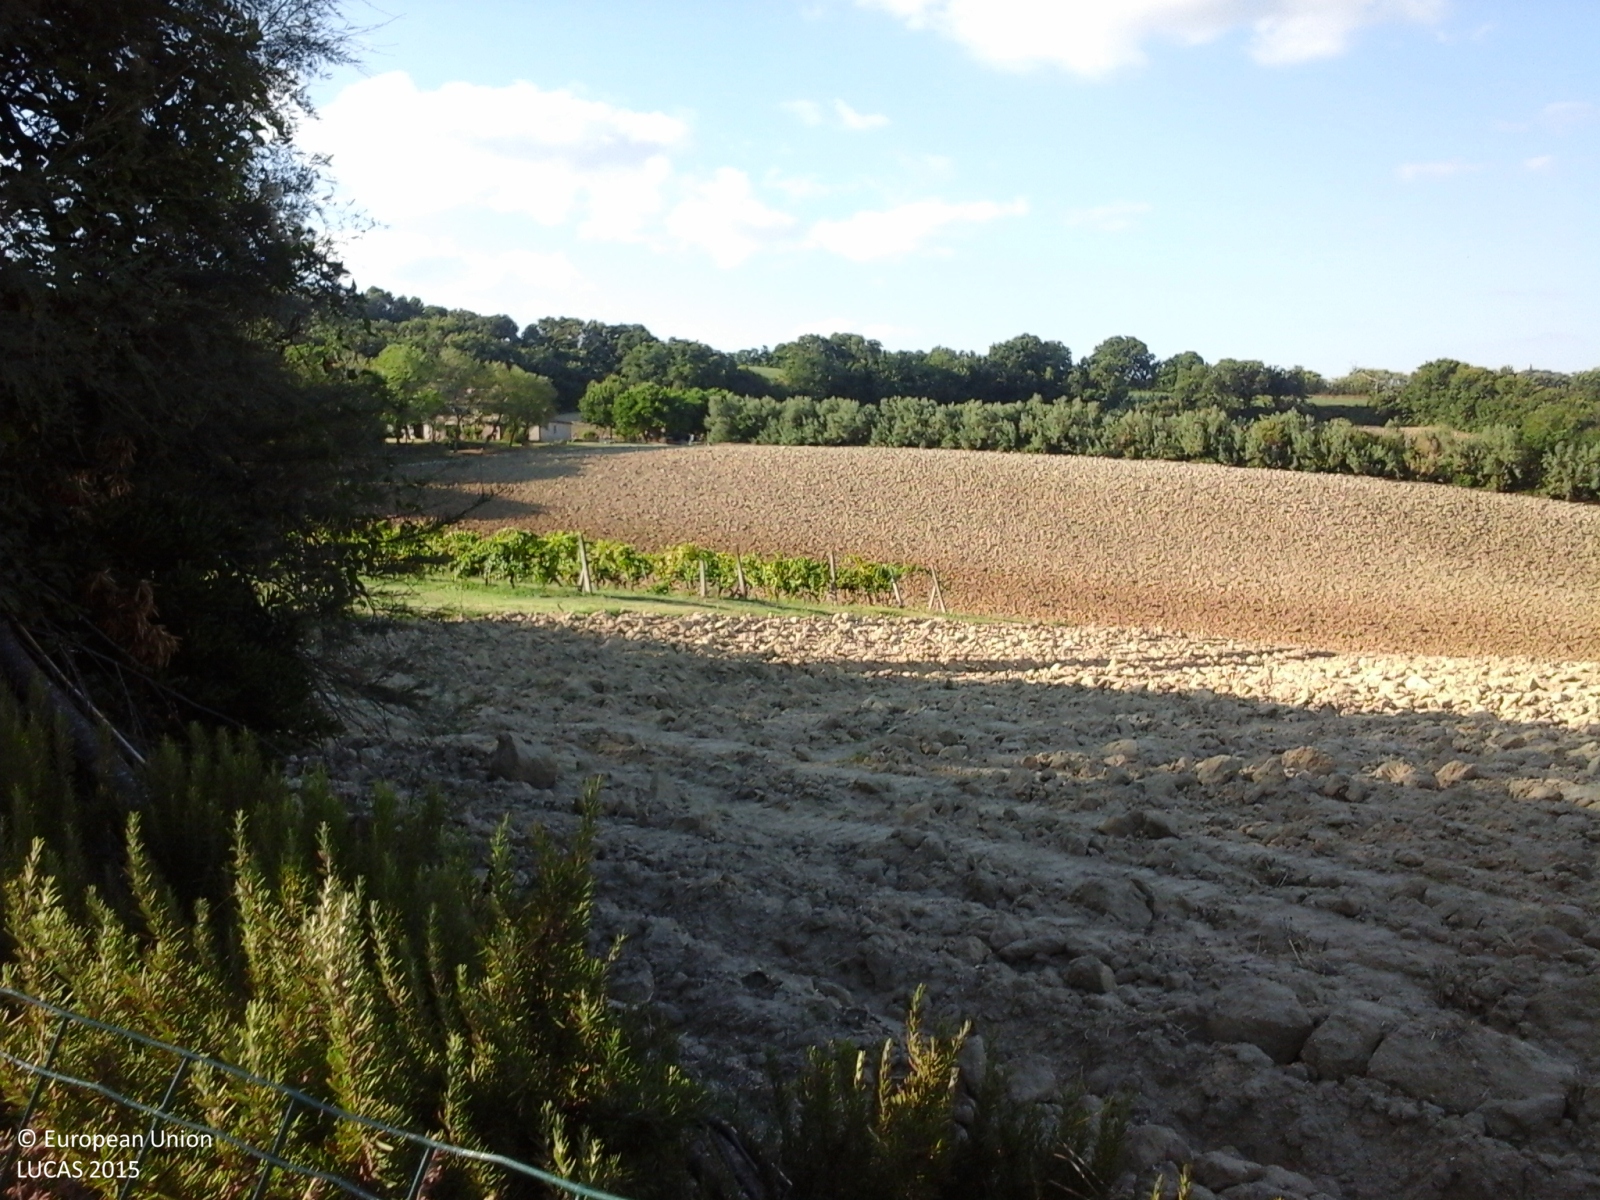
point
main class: Cropland
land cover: Durum wheat
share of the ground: < 10 %
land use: Agriculture (excluding fallow land and kitchen gardens)
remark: Harvested field
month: September
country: IT
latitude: 43.8749
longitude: 12.9674
